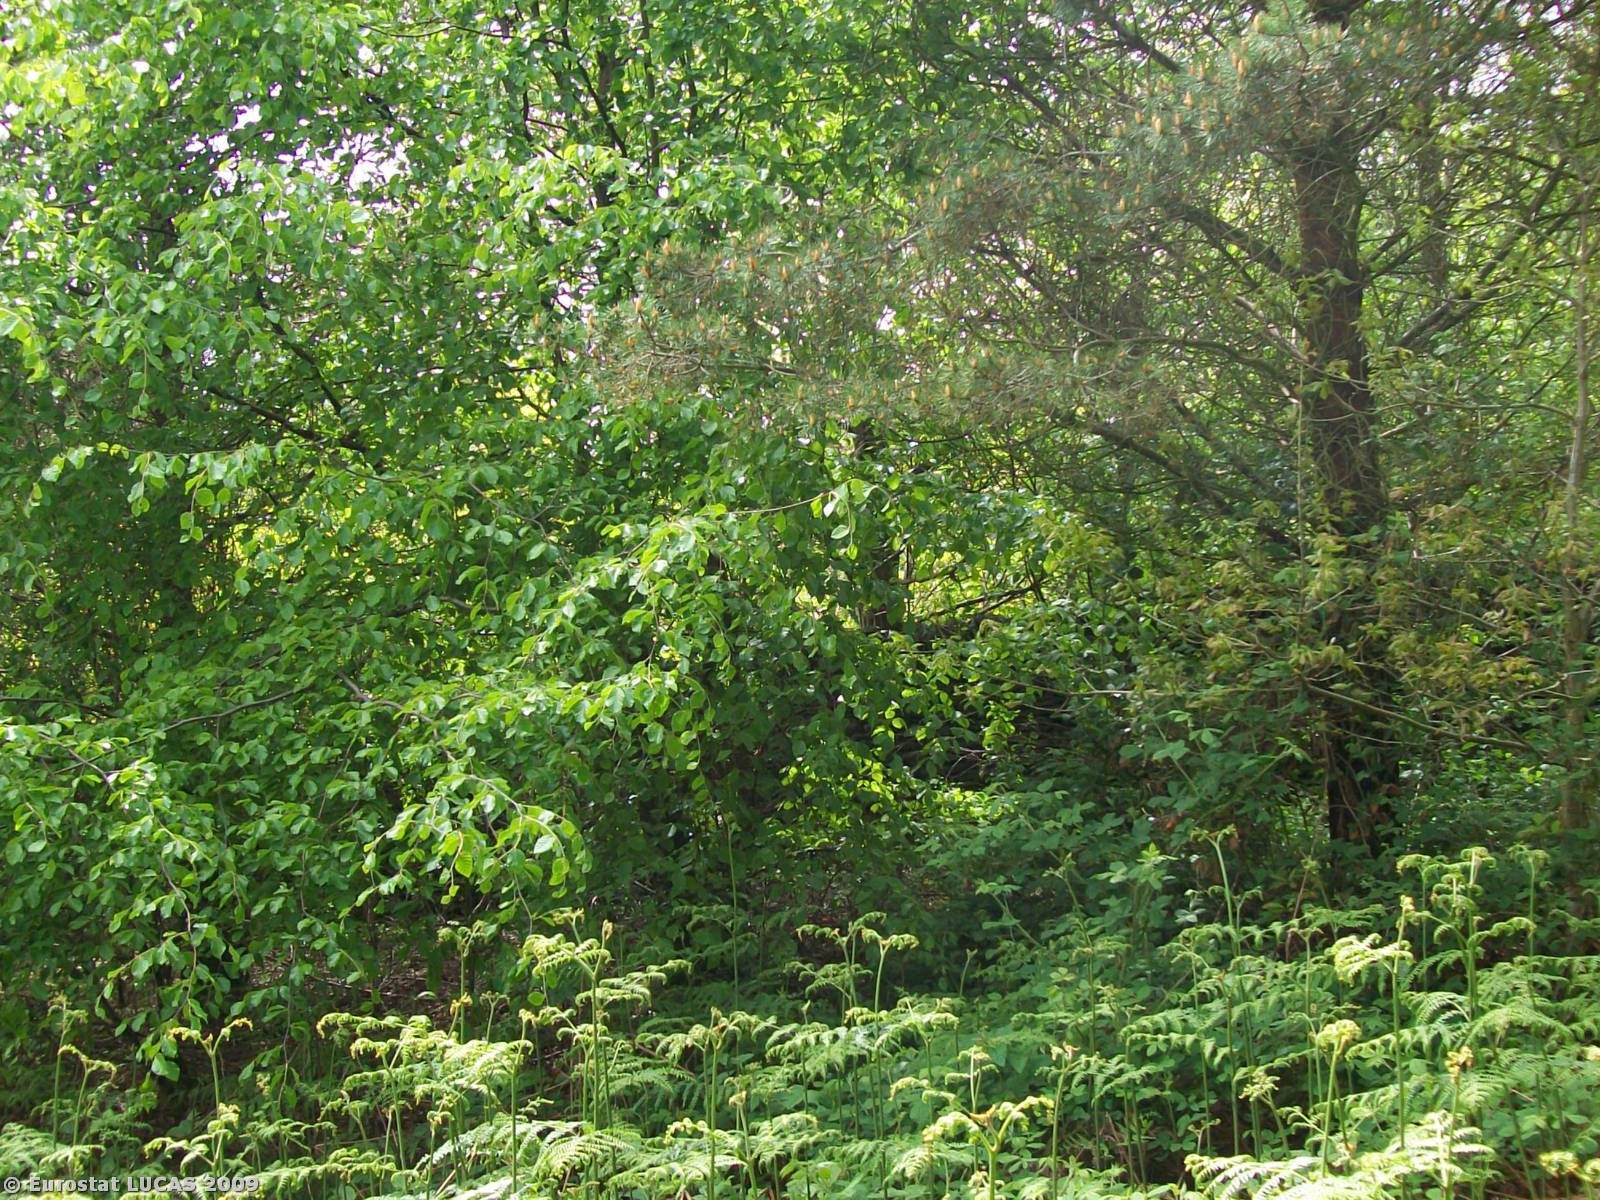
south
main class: Woodland
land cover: Mixed woodland
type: hemiboreal forest and nemoral coniferous forest and mixed broadleaved-coniferous forest
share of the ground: > 75 %
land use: Unused
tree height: > 5 m
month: May
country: GB
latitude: 53.1759
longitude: -4.0849
